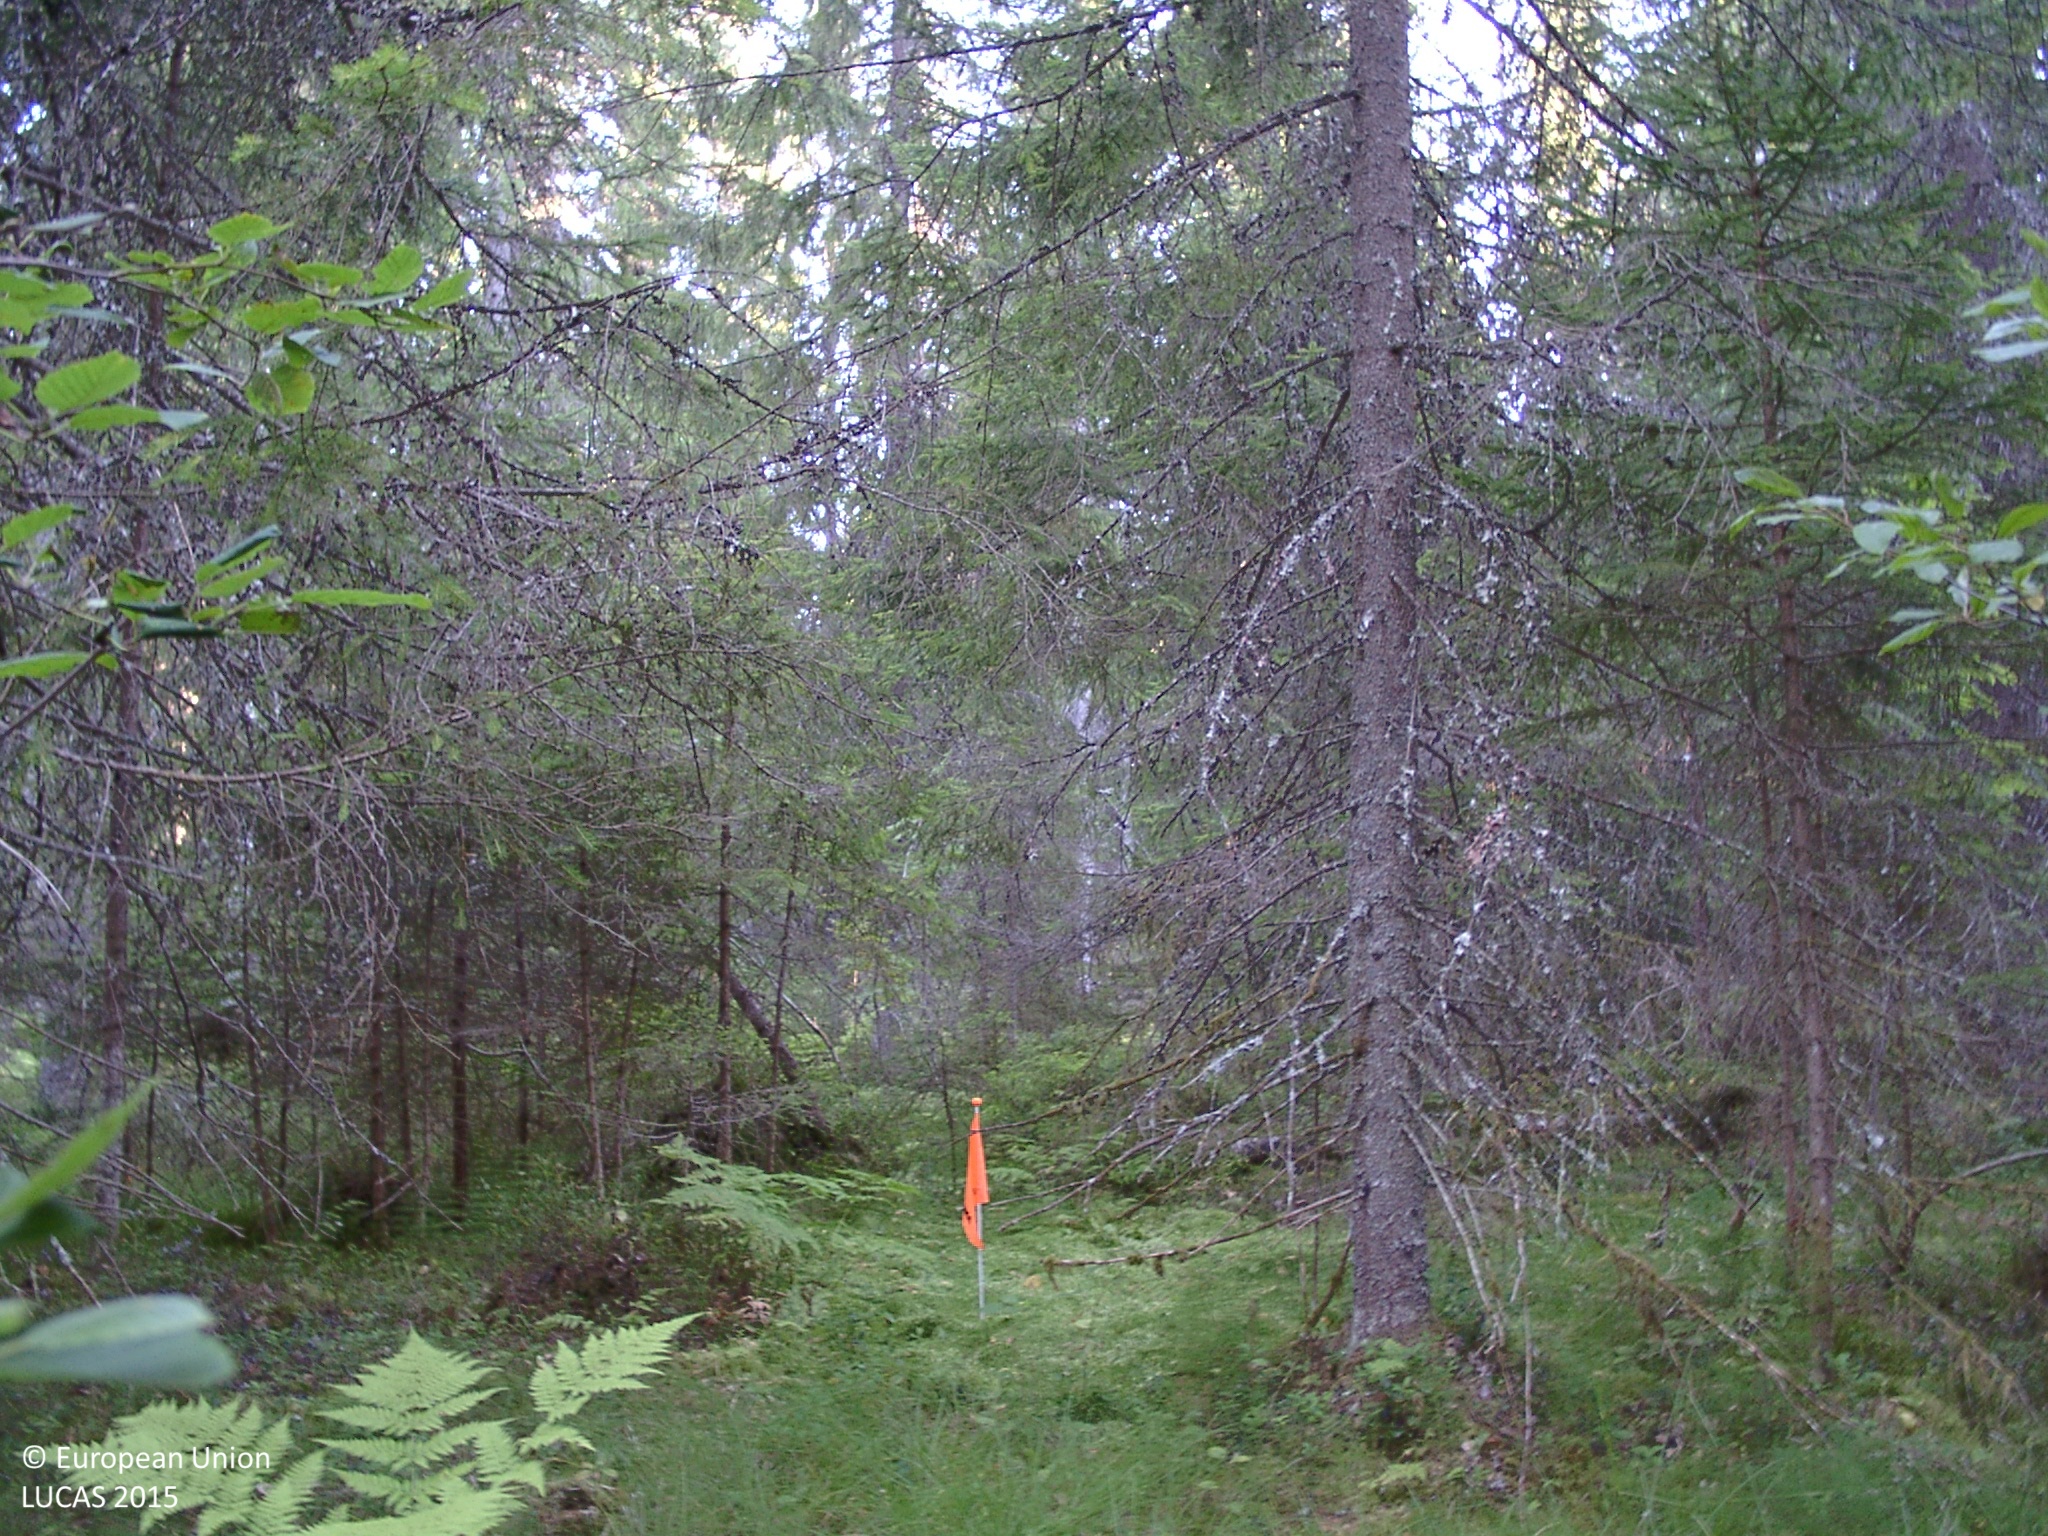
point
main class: Woodland
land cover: Spruce dominated coniferous woodland
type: boreal forest
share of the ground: > 75 %
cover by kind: coniferous forest trees 65 %, broadleaved forest trees 10 %, herbaceous plants 10 %, lichens and mosses 10 %, shrubs 5 %
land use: Forestry
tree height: > 5 m
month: August
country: FI
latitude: 62.4345
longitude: 25.2739
